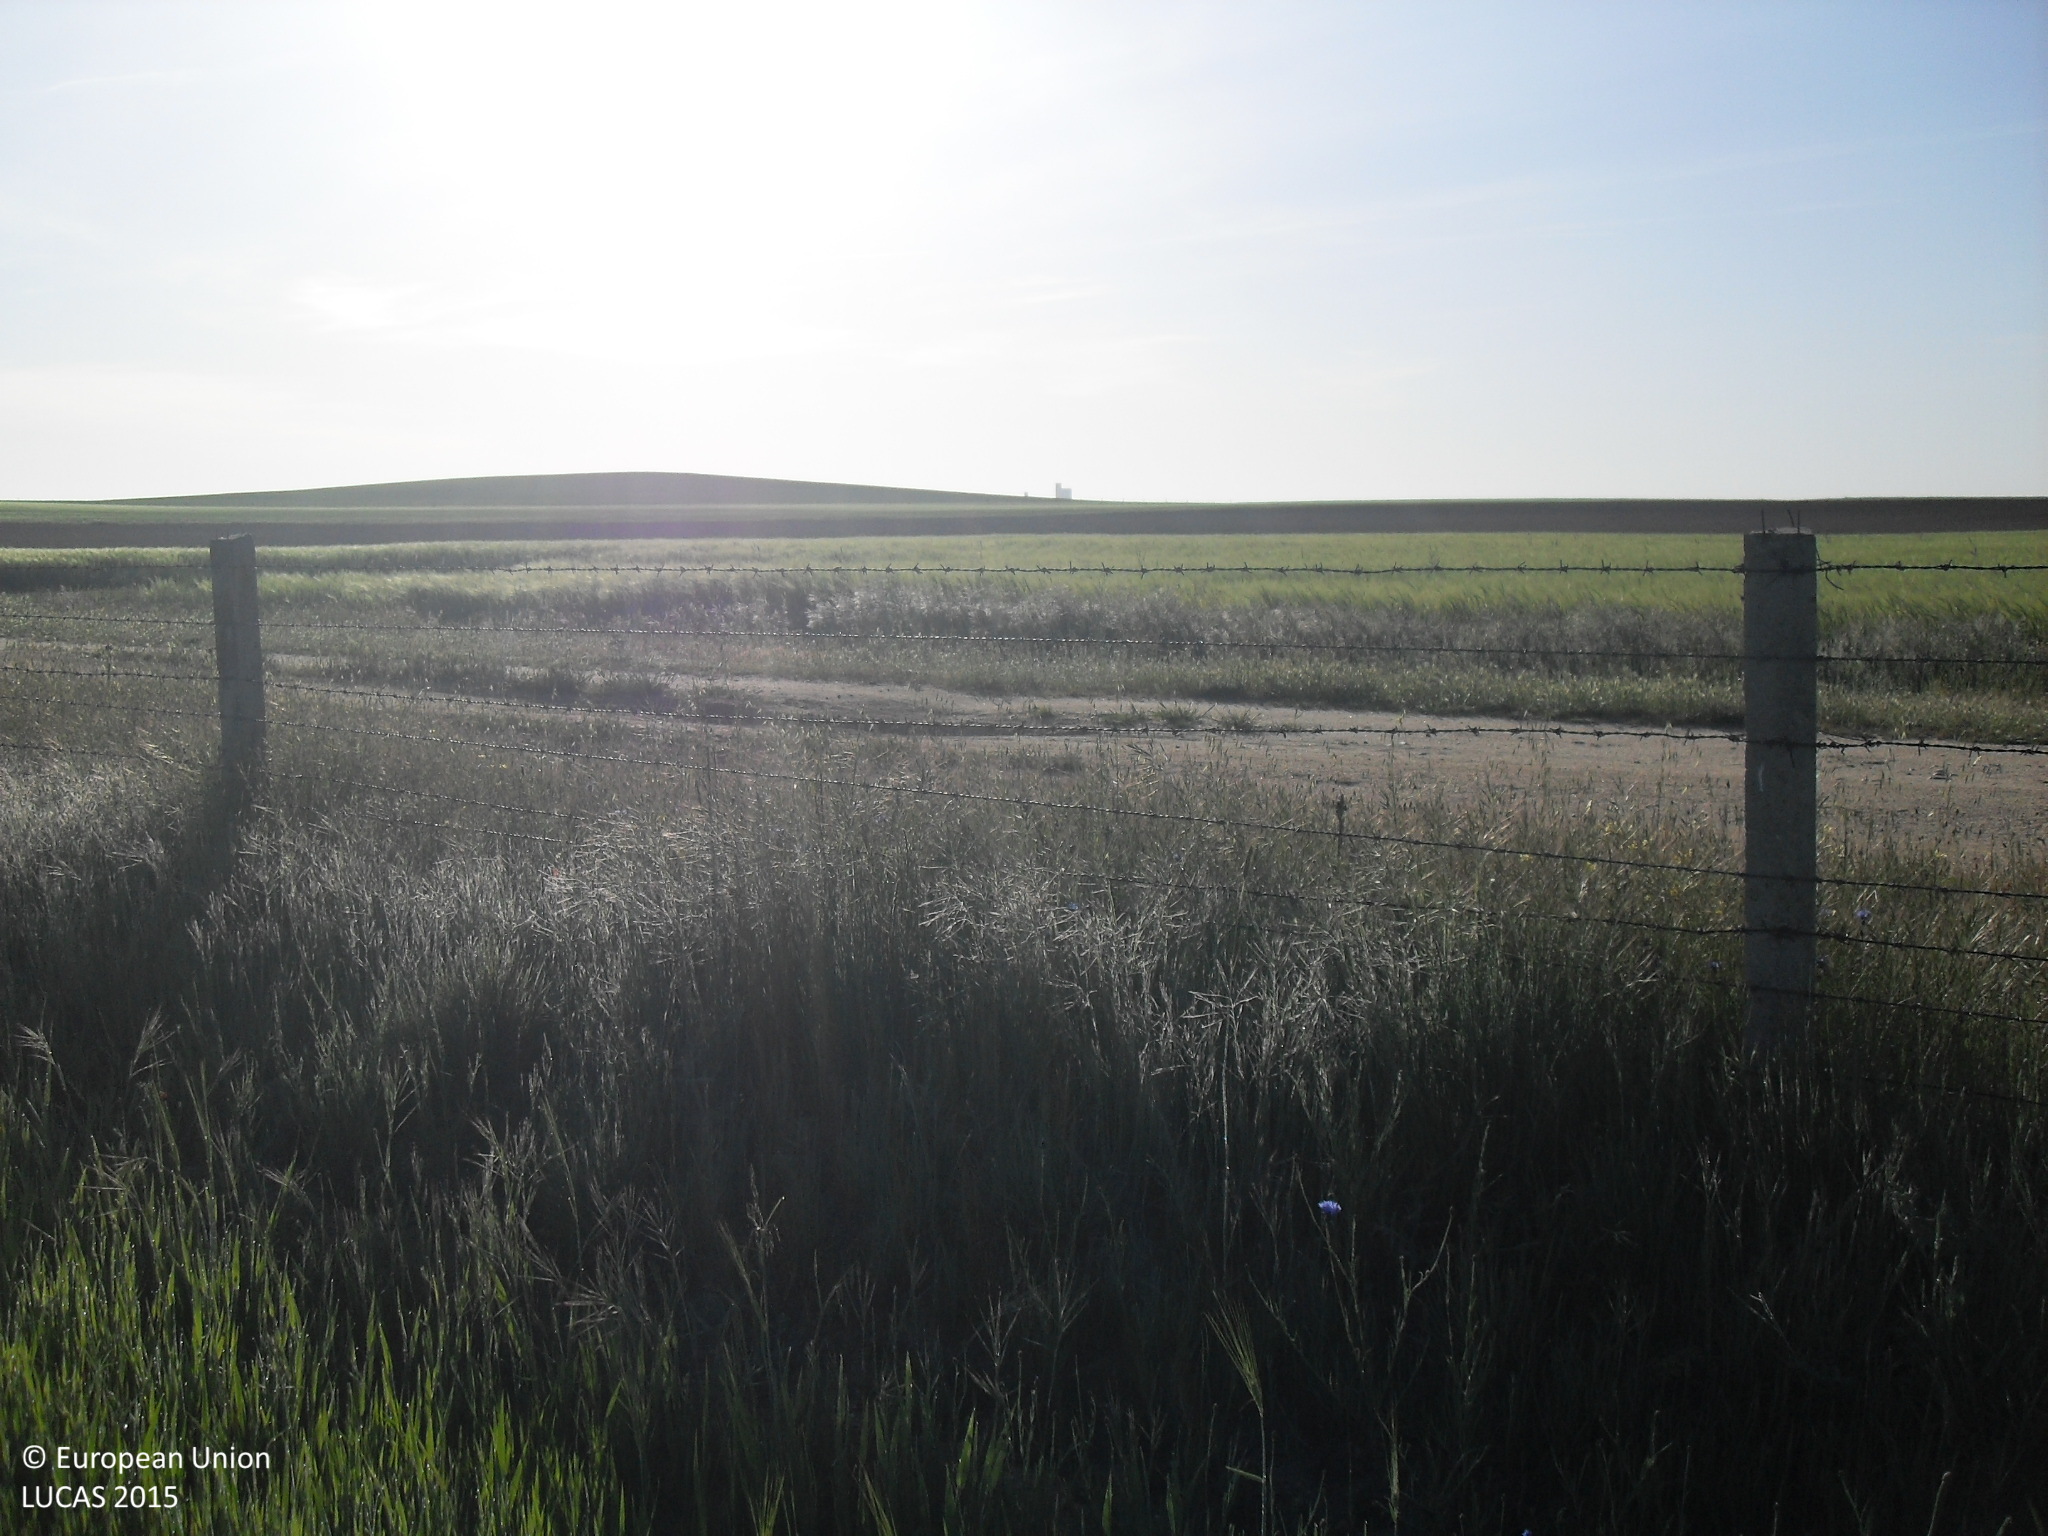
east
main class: Cropland
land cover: Oats
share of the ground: > 75 %
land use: Agriculture (excluding fallow land and kitchen gardens)
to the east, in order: Oats; Grass margins; Fences; Grass margins; Tracks; Grass margins; Barley; Other bare soil
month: May
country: ES
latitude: 40.9002
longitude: -5.2752
